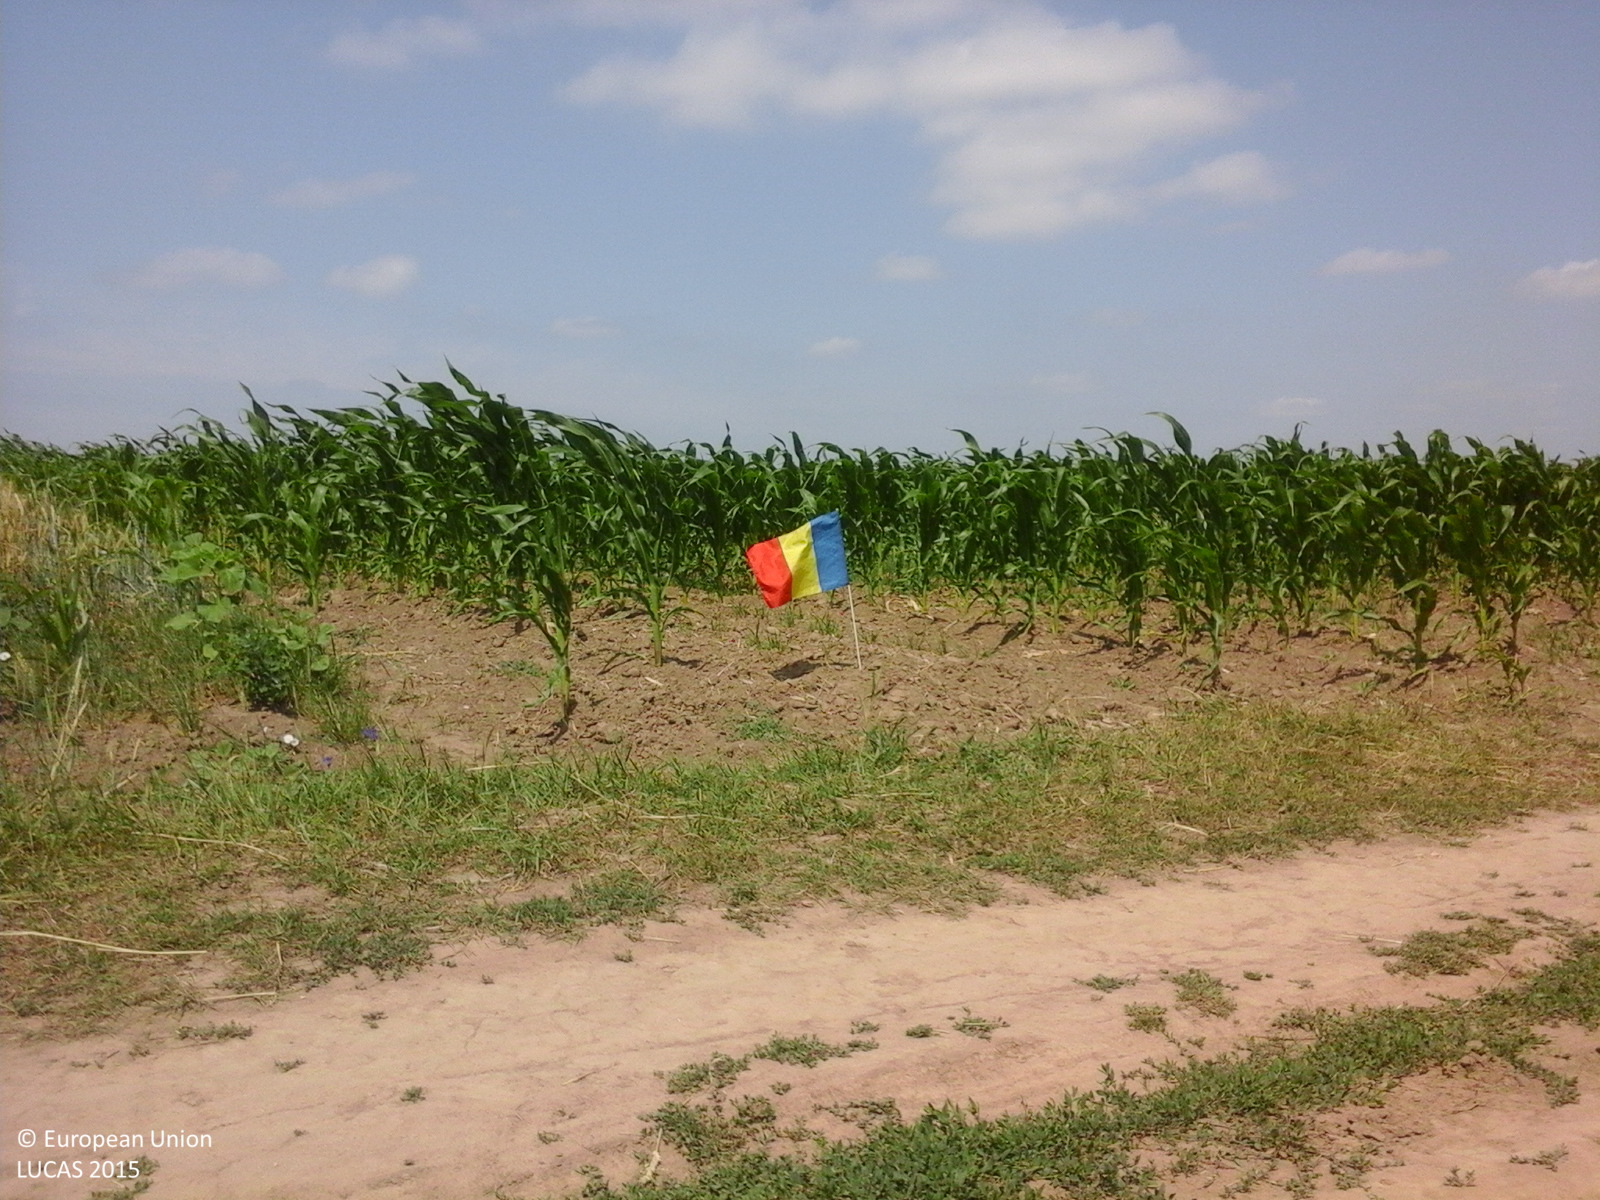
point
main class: Cropland
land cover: Maize
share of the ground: > 75 %
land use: Agriculture (excluding fallow land and kitchen gardens)
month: June
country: RO
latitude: 46.7571
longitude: 27.0266
